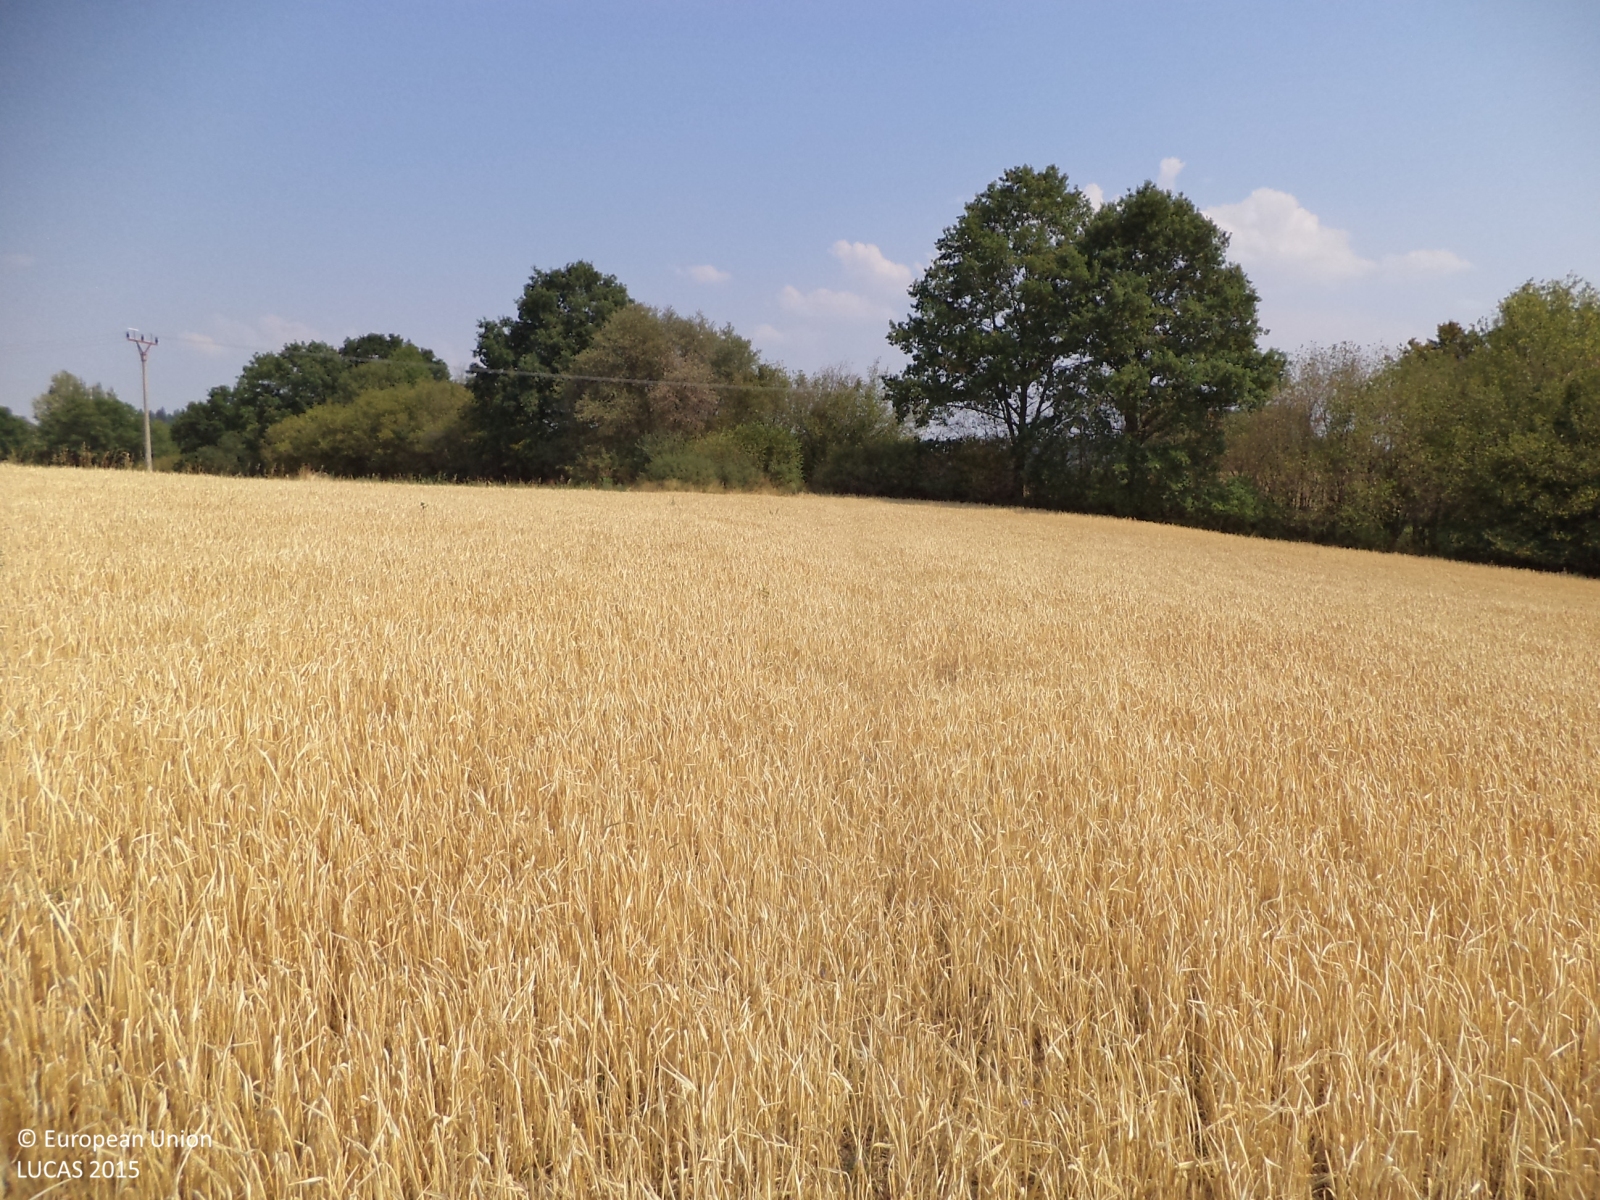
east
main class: Cropland
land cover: Barley
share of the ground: > 75 %
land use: Agriculture (excluding fallow land and kitchen gardens)
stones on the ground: < 10 %
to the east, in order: Barley; Tracks; Electric lines; Shrubland with sparse tree cover; Tracks; Grassland without tree/shrub cover; Common wheat
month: August
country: CZ
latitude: 49.5037
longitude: 14.4340
